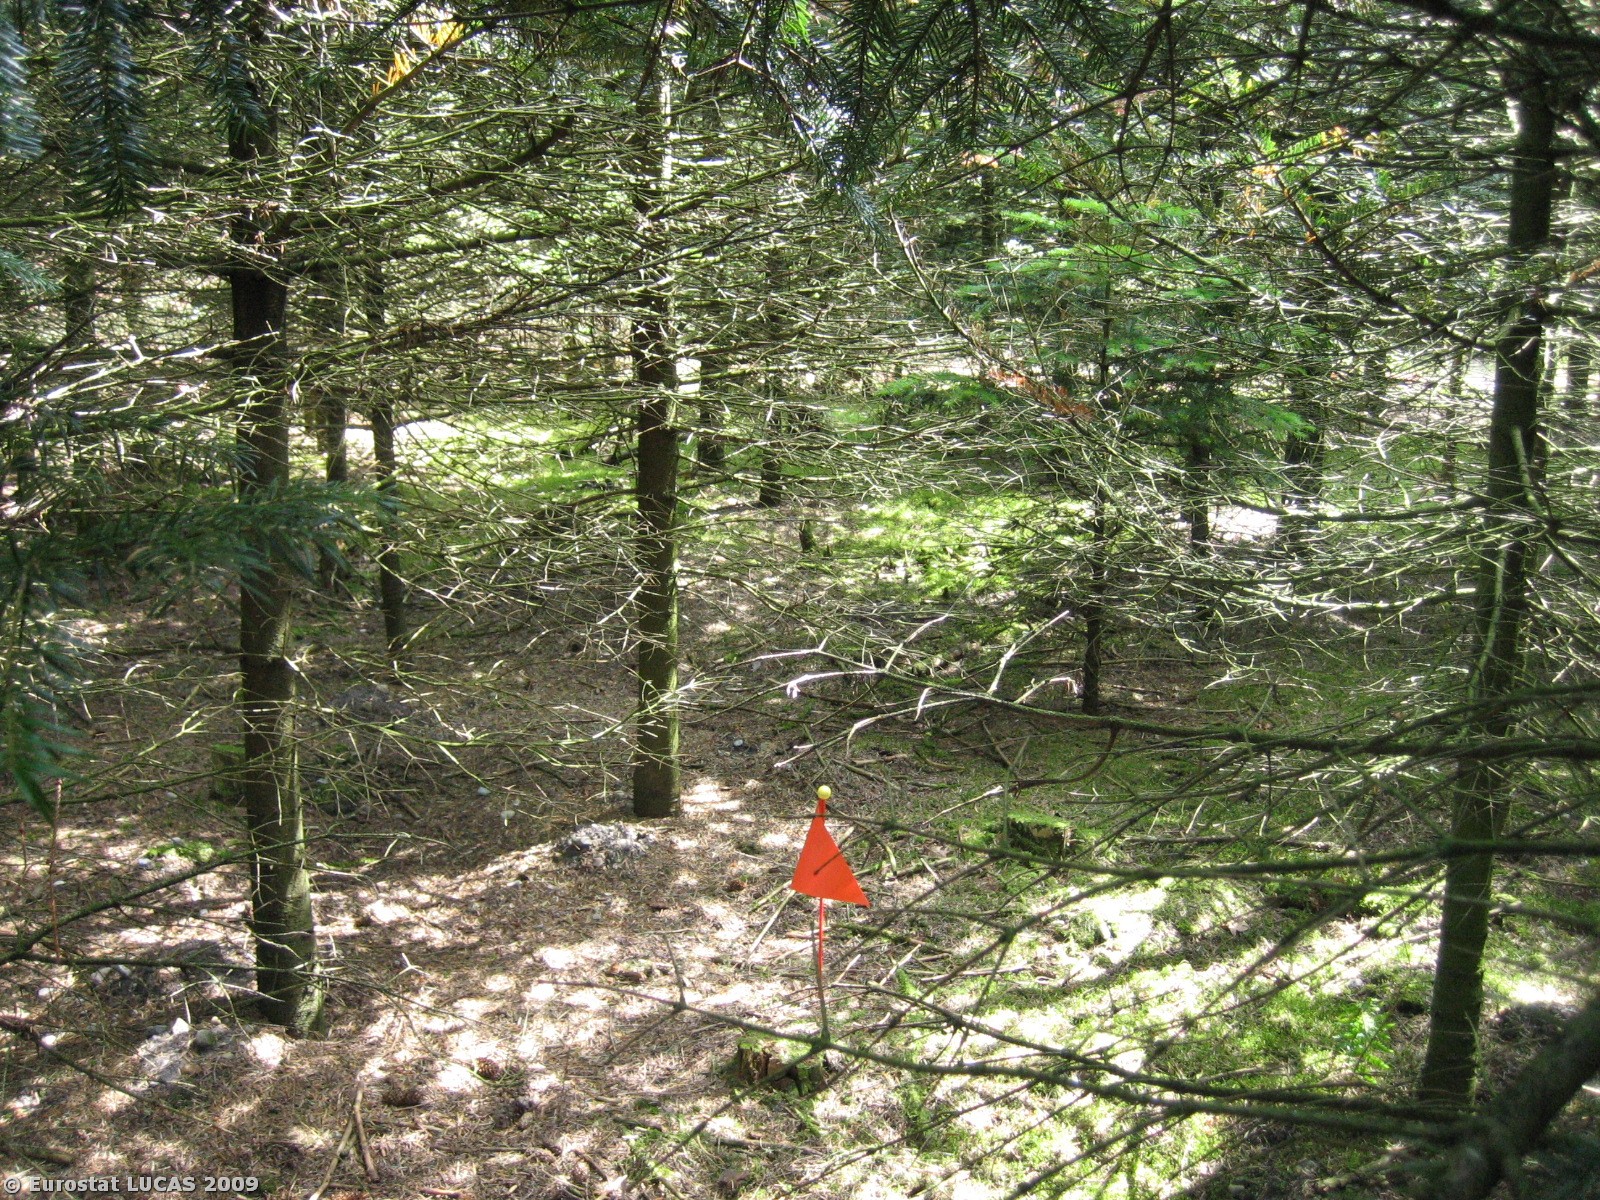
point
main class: Woodland
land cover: Coniferous woodland
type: hemiboreal forest and nemoral coniferous forest and mixed broadleaved-coniferous forest
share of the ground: > 75 %
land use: Forestry
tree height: > 5 m
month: July
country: DK
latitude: 55.6977
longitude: 8.9033
